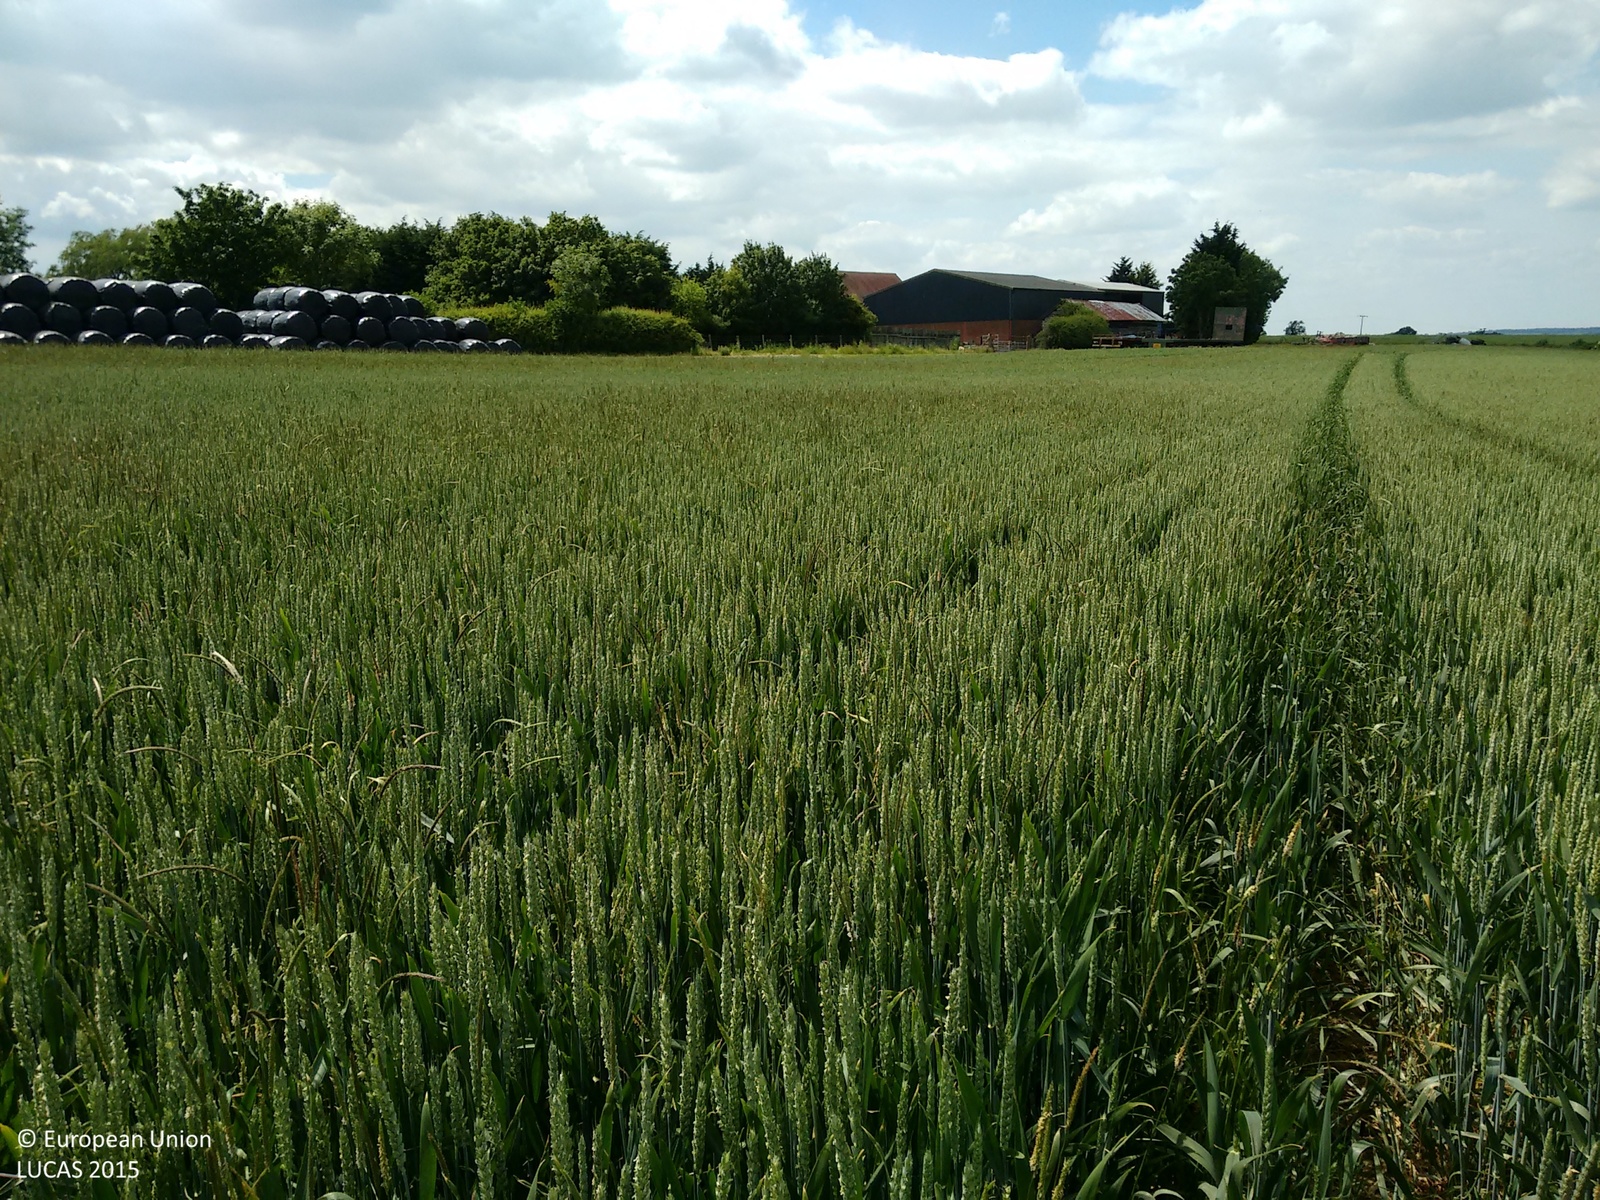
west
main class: Cropland
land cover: Common wheat
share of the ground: > 75 %
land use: Agriculture (excluding fallow land and kitchen gardens)
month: June
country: GB
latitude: 52.0759
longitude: -0.6769
